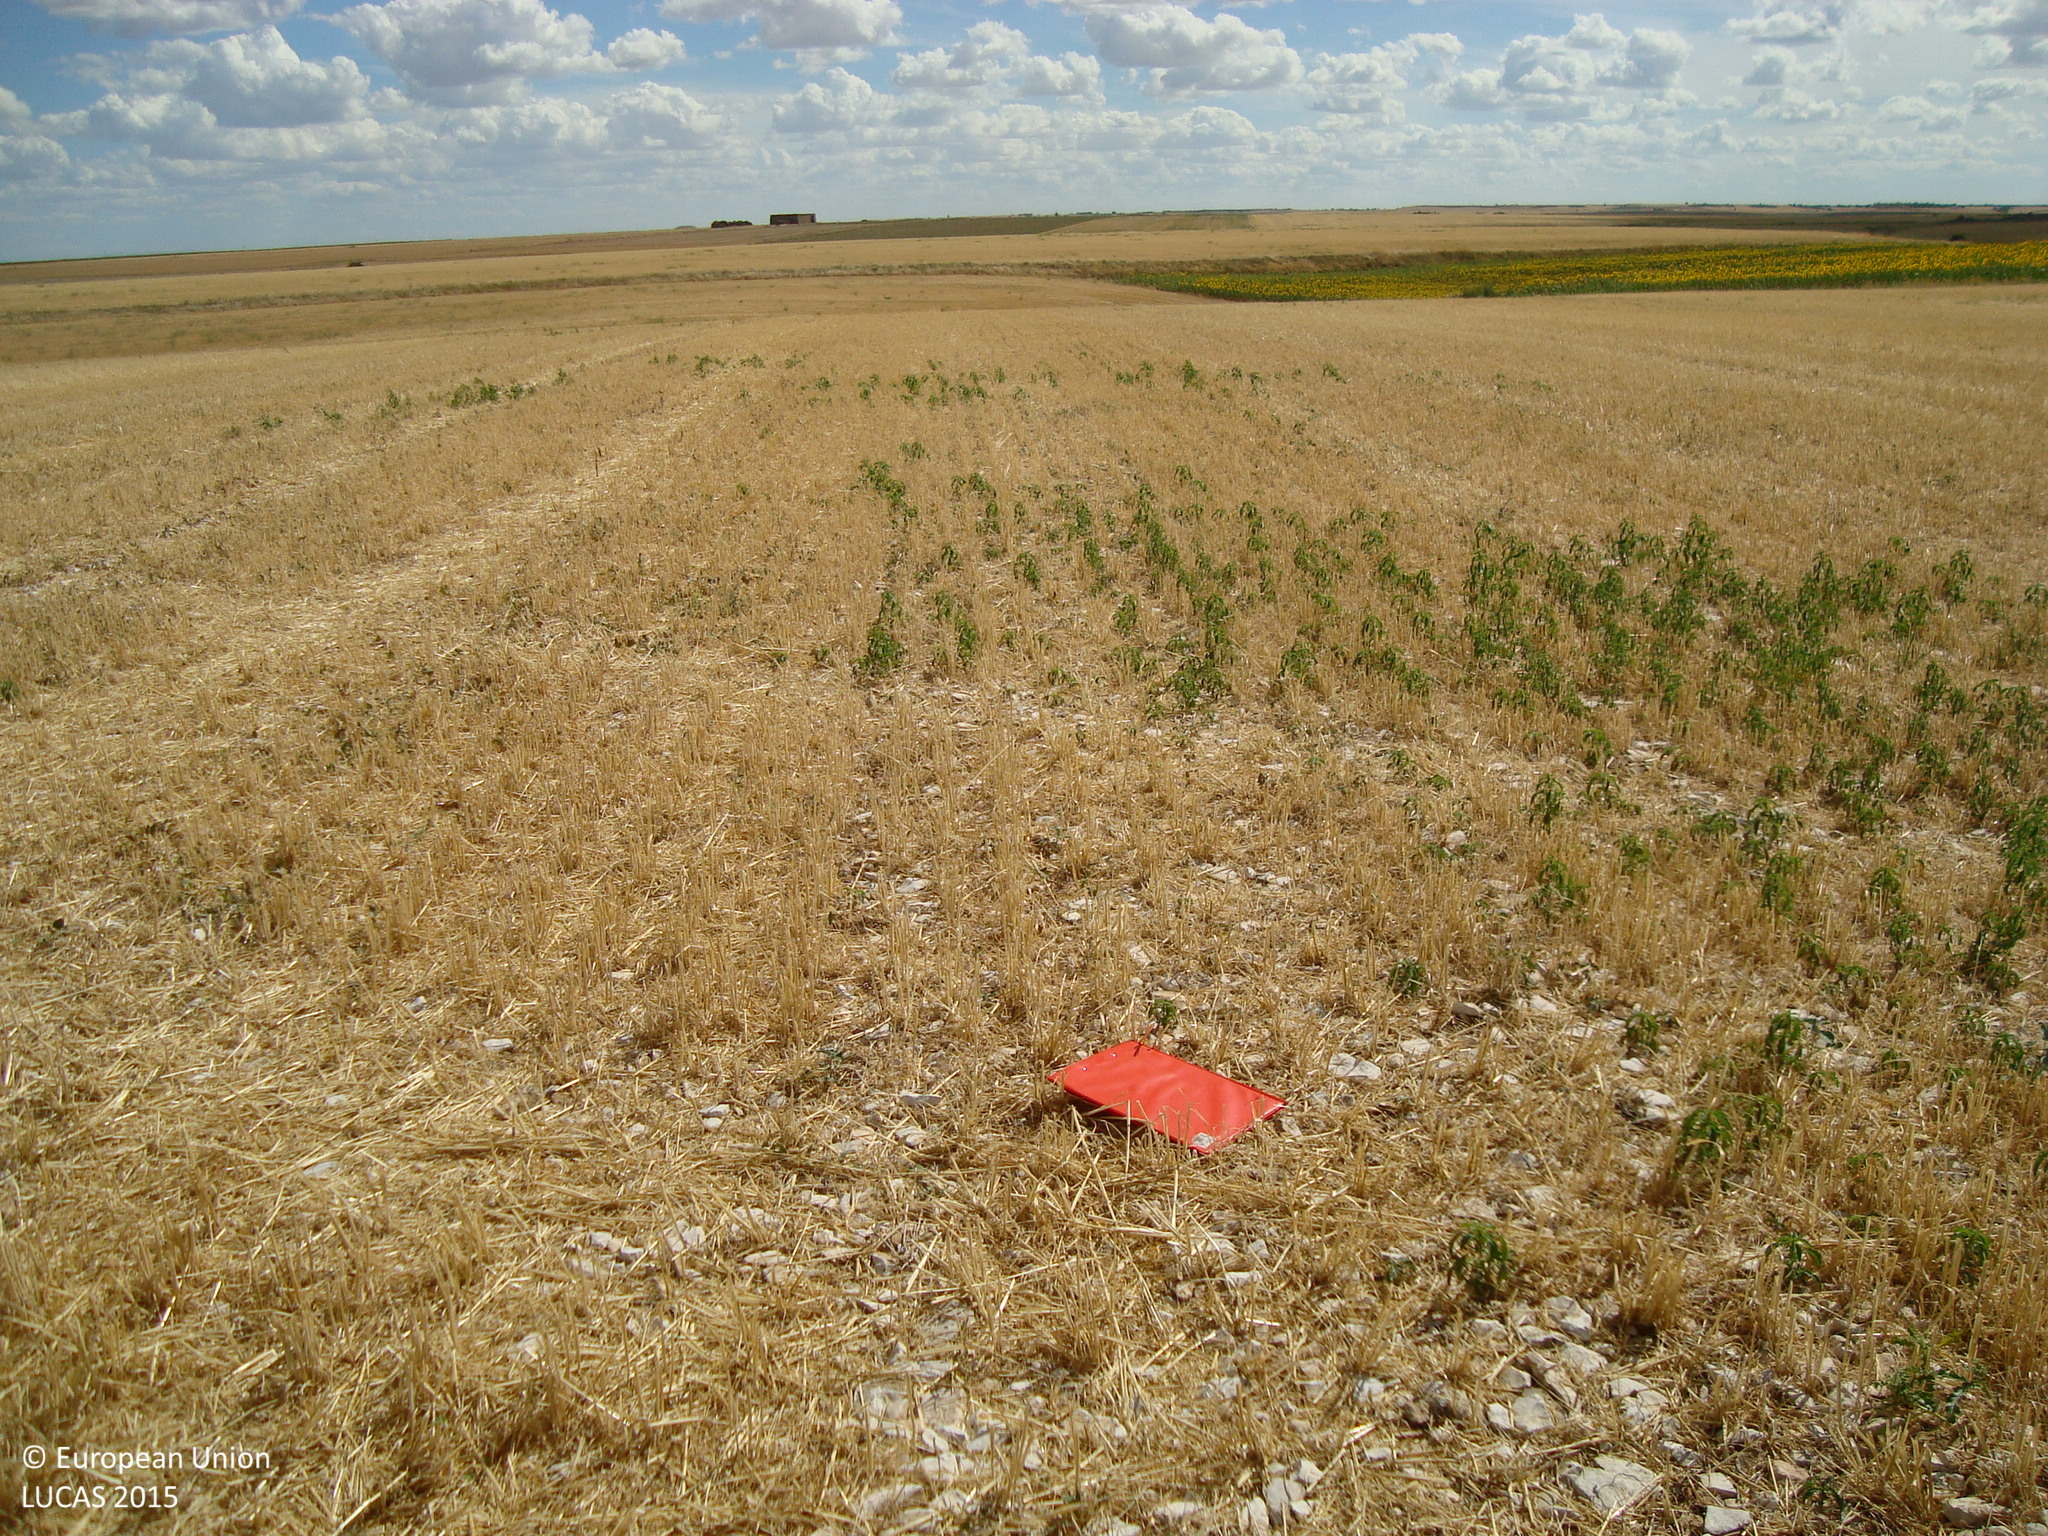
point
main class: Cropland
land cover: Common wheat
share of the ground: > 75 %
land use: Agriculture (excluding fallow land and kitchen gardens)
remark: Harvested field
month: July
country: ES
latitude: 41.9472
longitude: -3.8951
